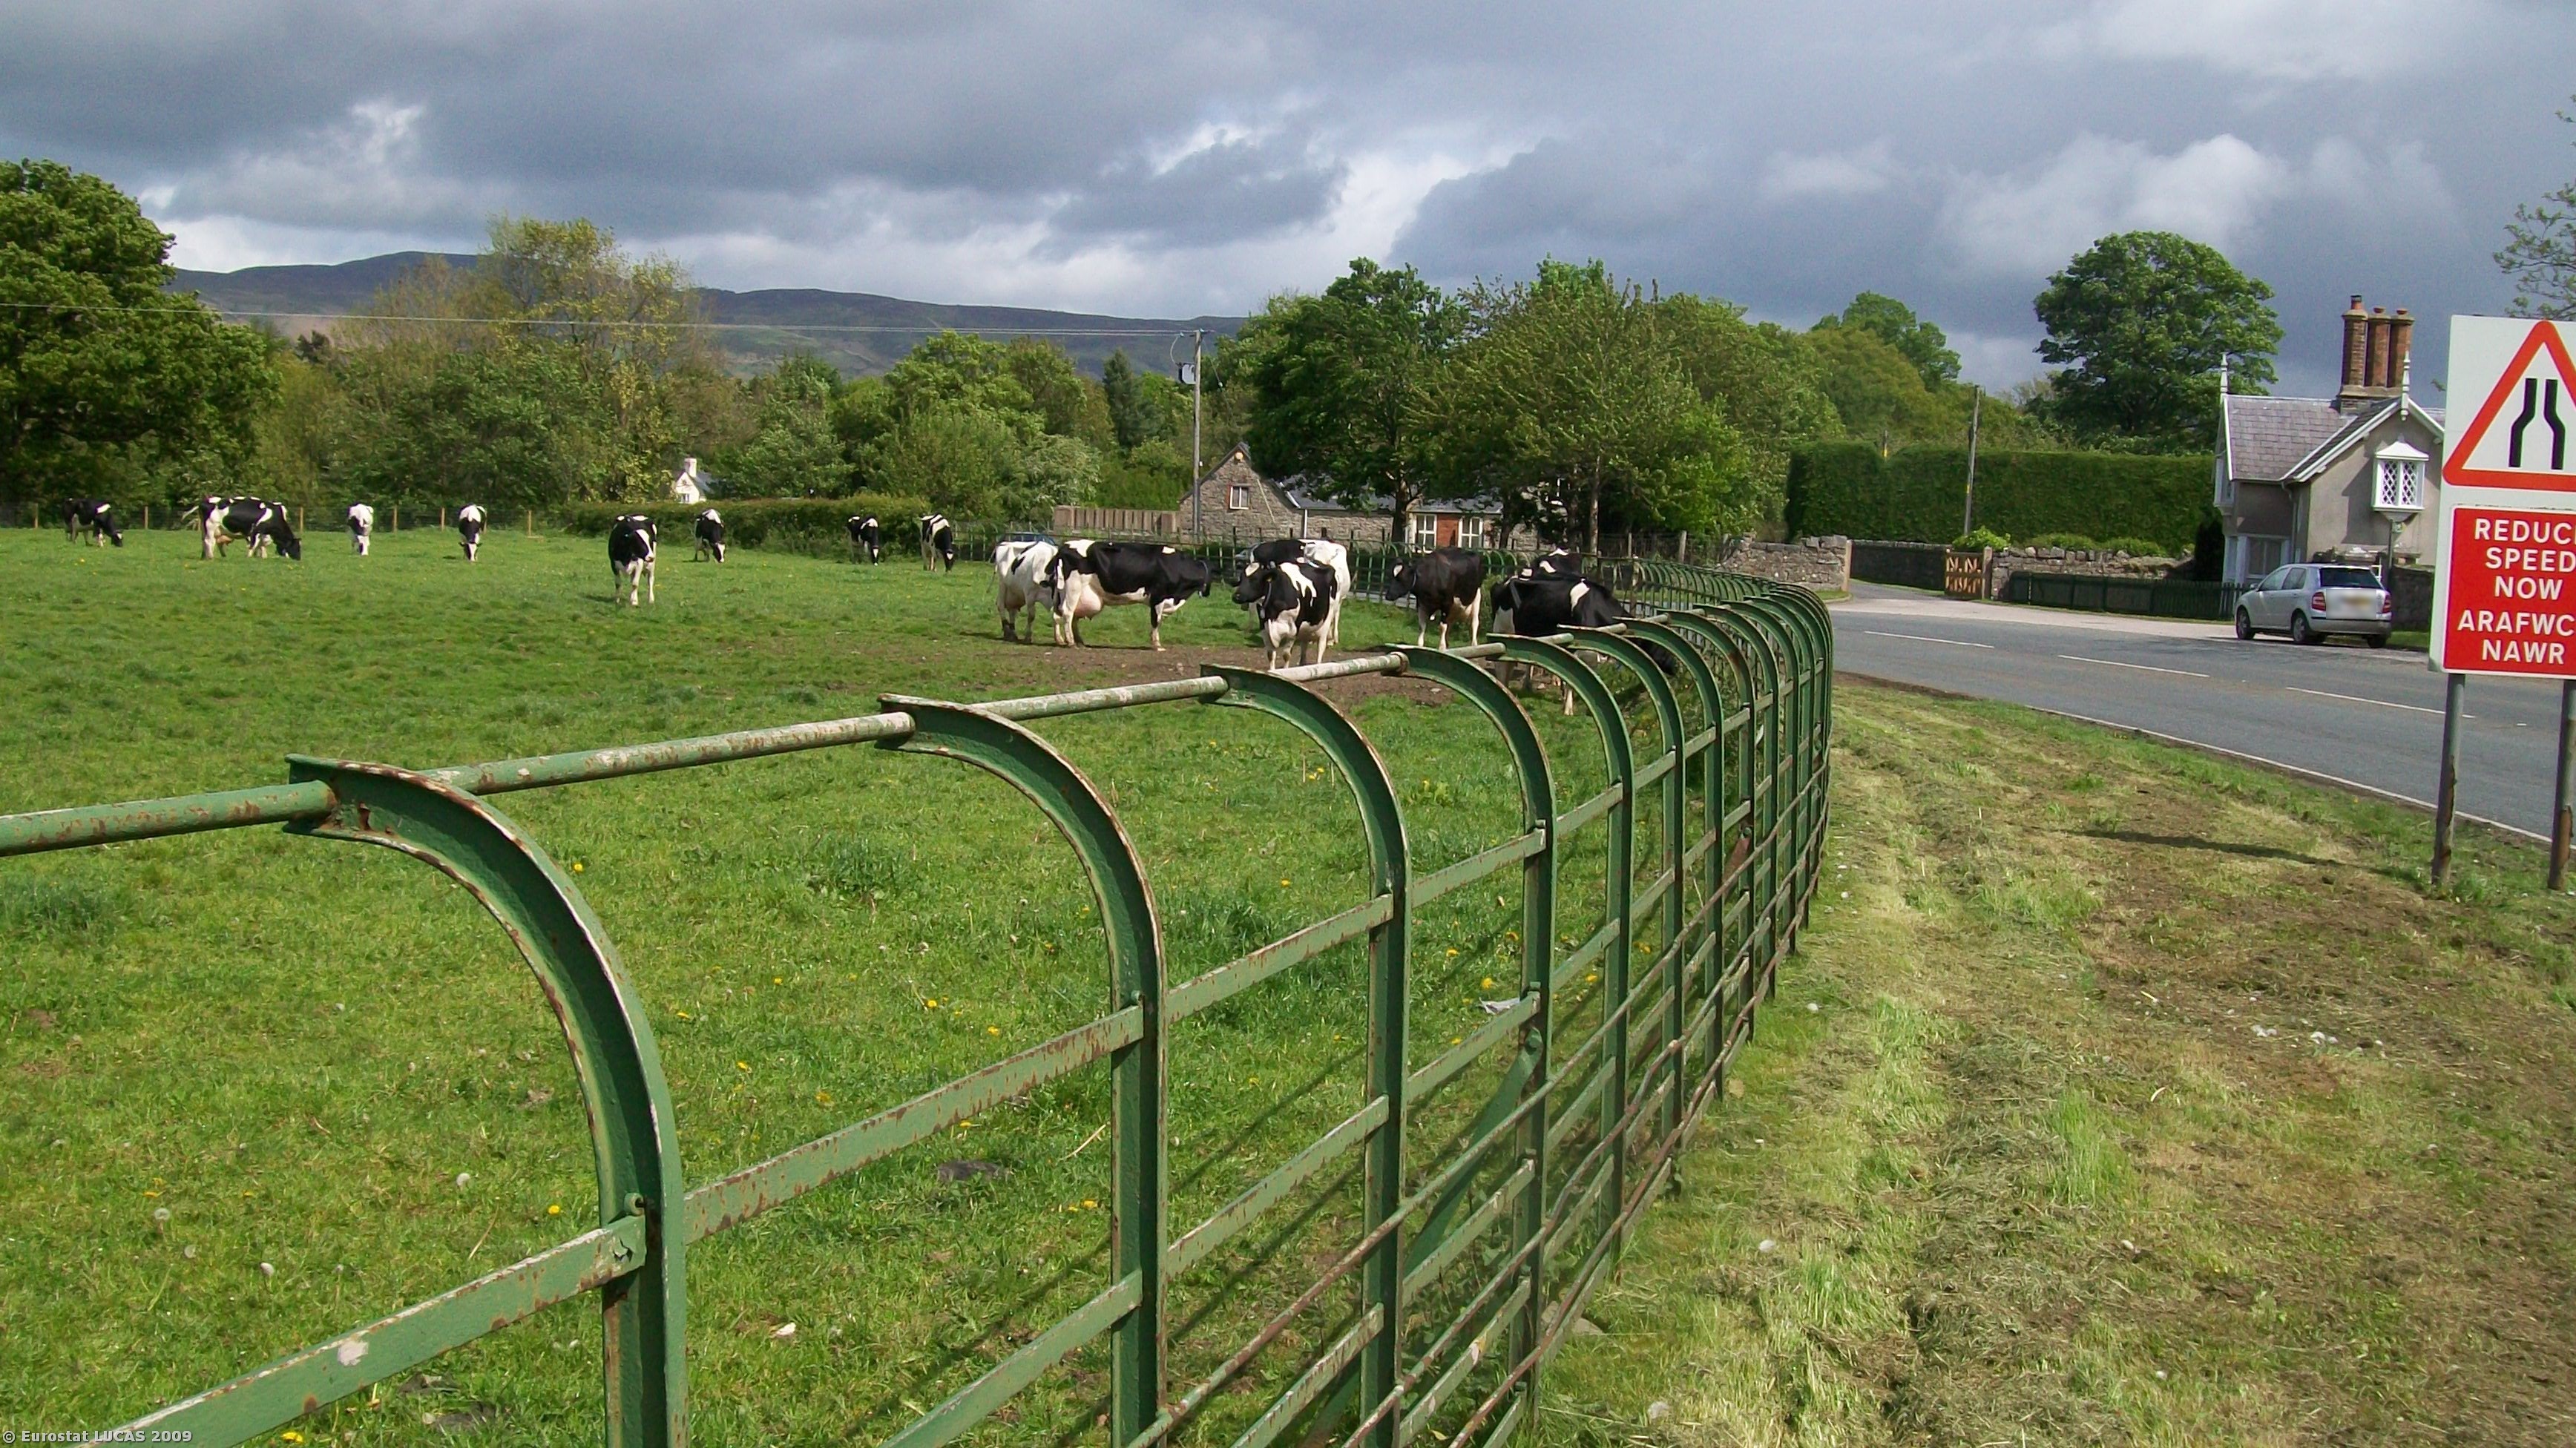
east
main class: Grassland
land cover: Grassland without tree/shrub cover
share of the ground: > 75 %
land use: Agriculture (excluding fallow land and kitchen gardens)
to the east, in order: Grassland without tree/shrub cover; Managed hedges; Grass margins; Paved roads, cycling and walking lanes; Dry stone walls; Fences; Artificial constructions in urban areas; Dry stone walls; Managed hedges; Broadleaved woodland
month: May
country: GB
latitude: 53.1338
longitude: -3.3387
